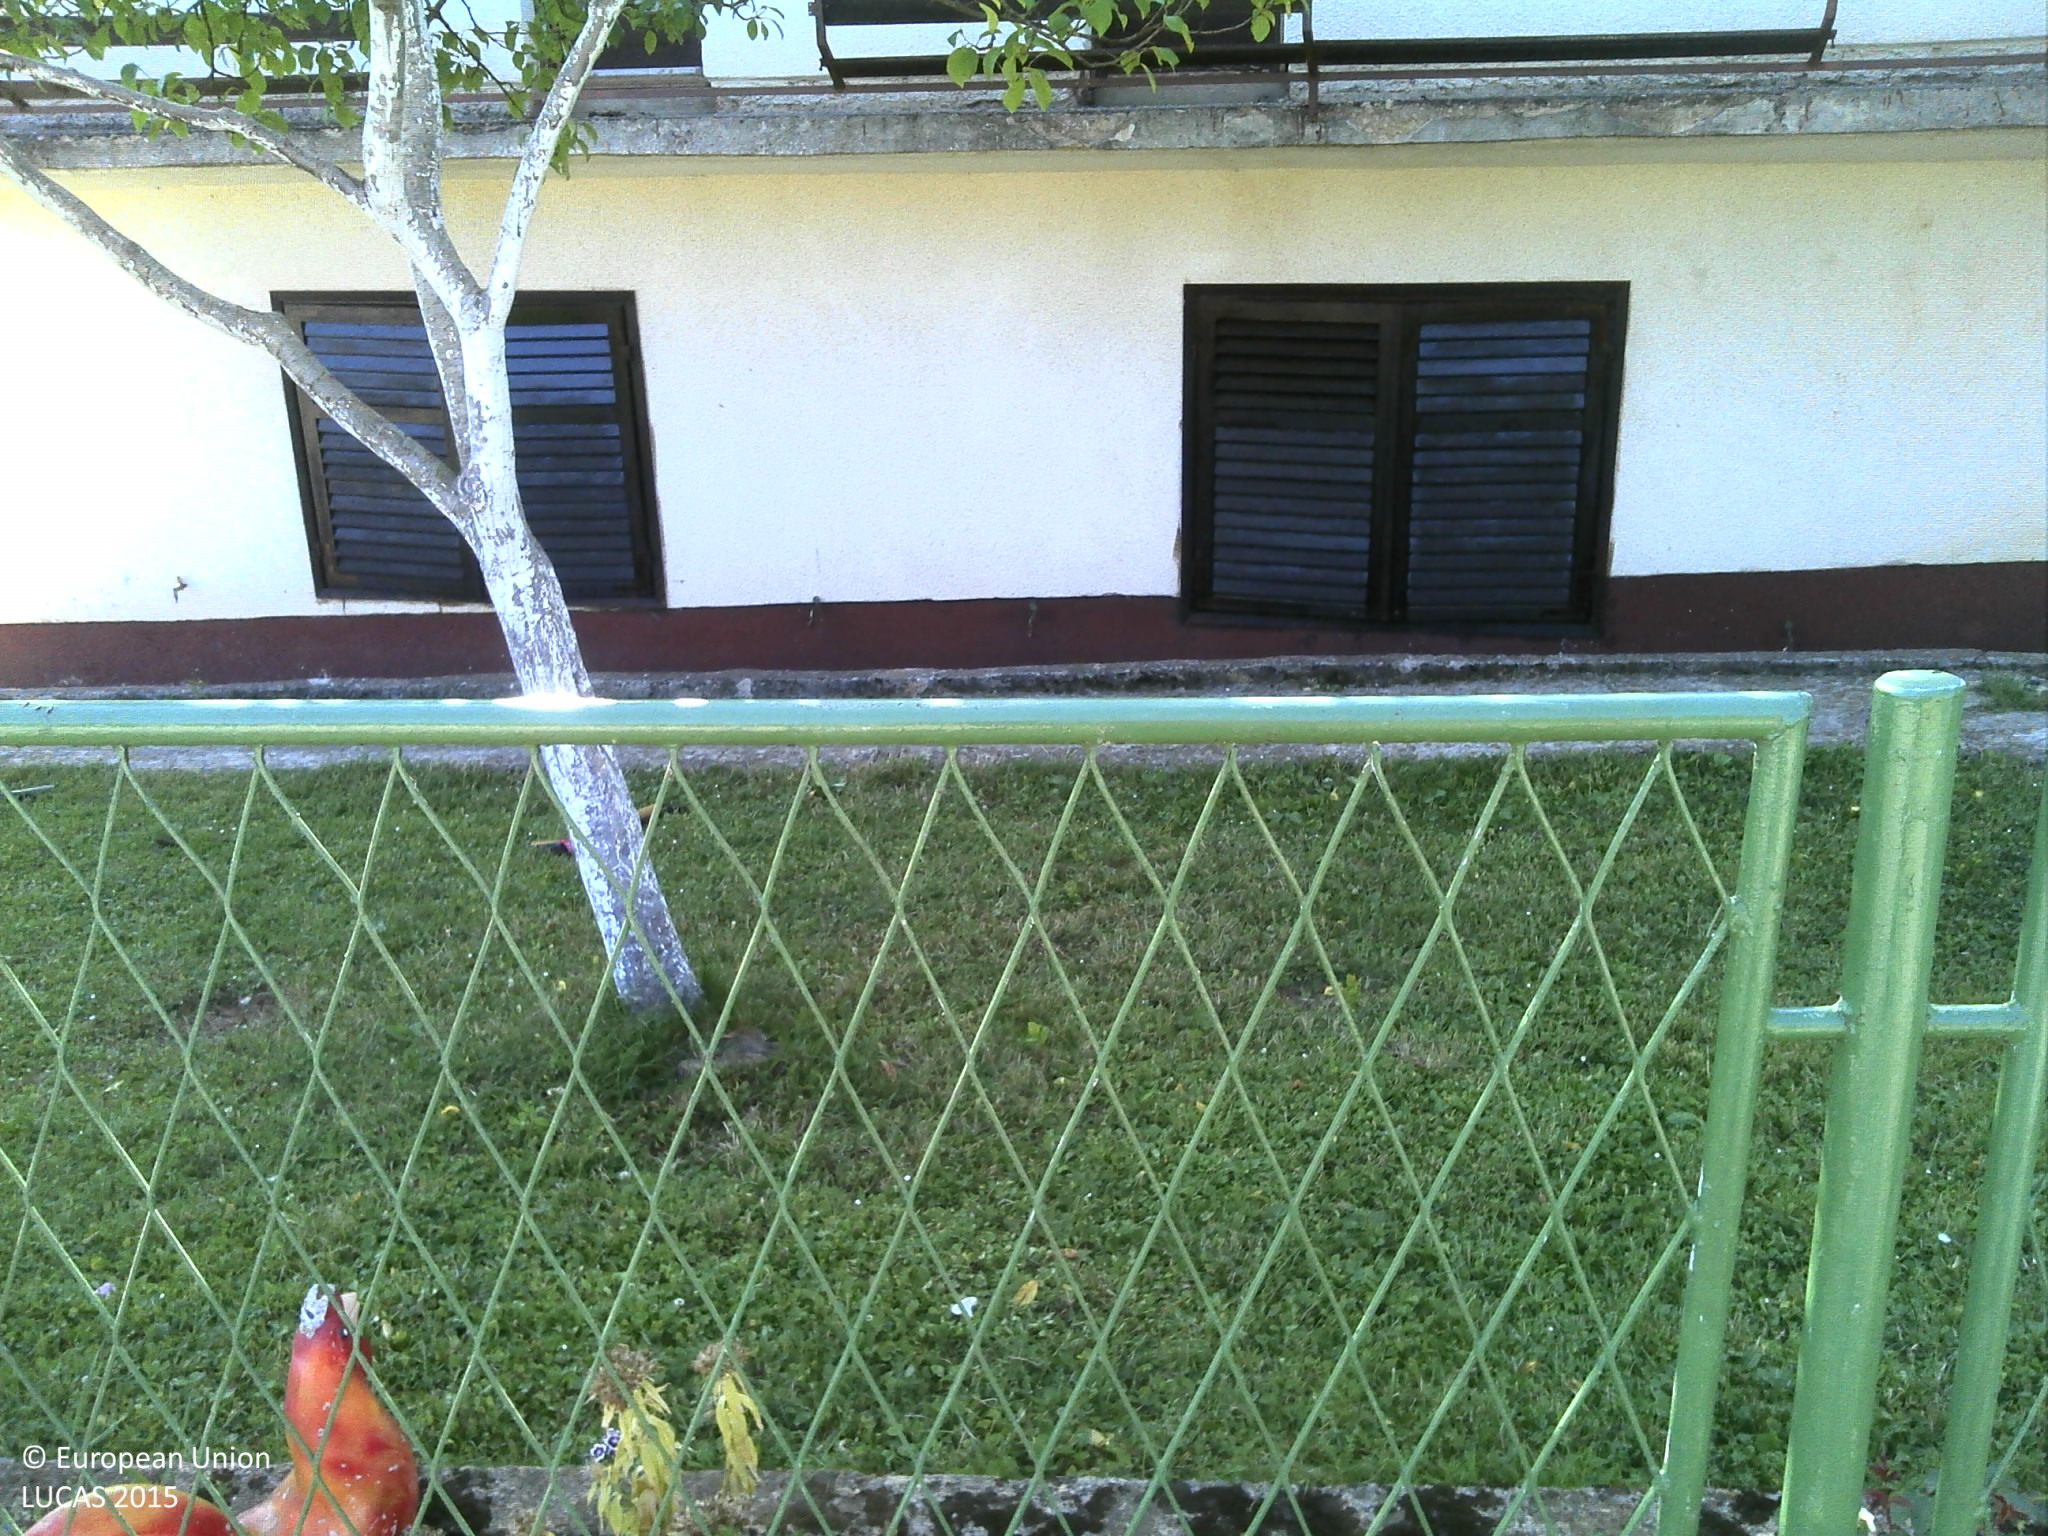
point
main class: Cropland
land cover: Other fruit trees and berries
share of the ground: 10 - 25 %
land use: Kitchen garden
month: July
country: HR
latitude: 44.8720
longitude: 15.1712
